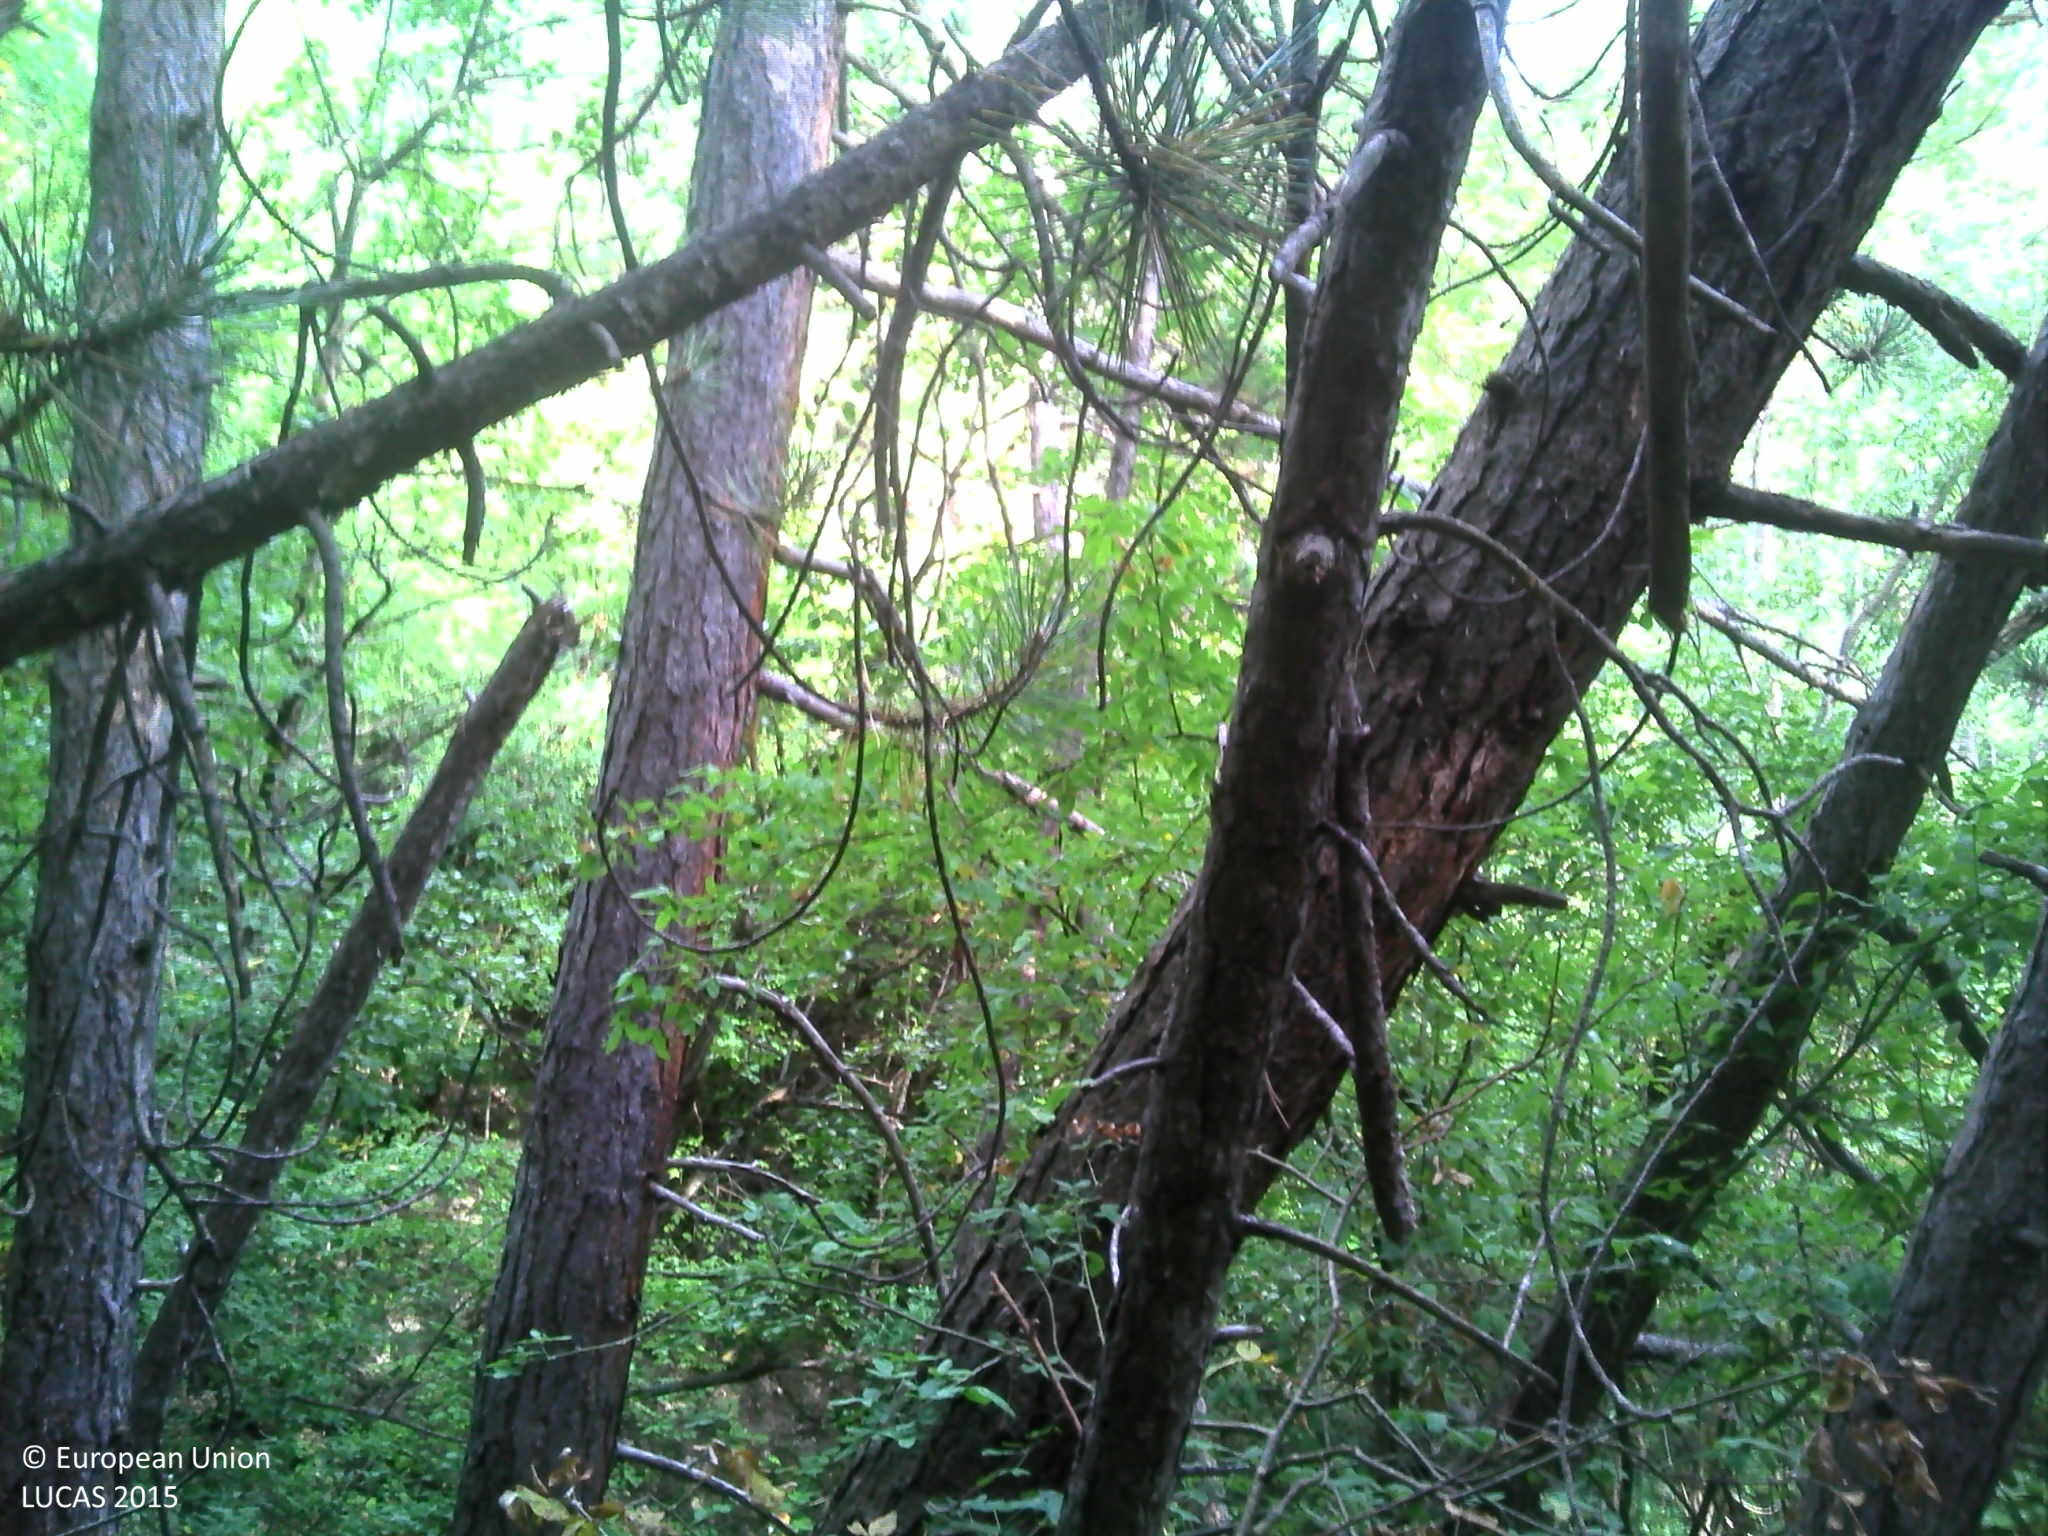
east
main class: Woodland
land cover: Pine dominated coniferous woodland
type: coniferous forest of the mediterranean region
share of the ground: > 75 %
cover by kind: coniferous forest trees 85 %, shrubs 10 %, broadleaved forest trees 5 %
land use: Semi-natural and natural areas not in use
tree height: > 5 m
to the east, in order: Pine dominated coniferous woodland; Tracks; Pine dominated coniferous woodland
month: September
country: FR
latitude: 44.6336
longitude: 5.5316
